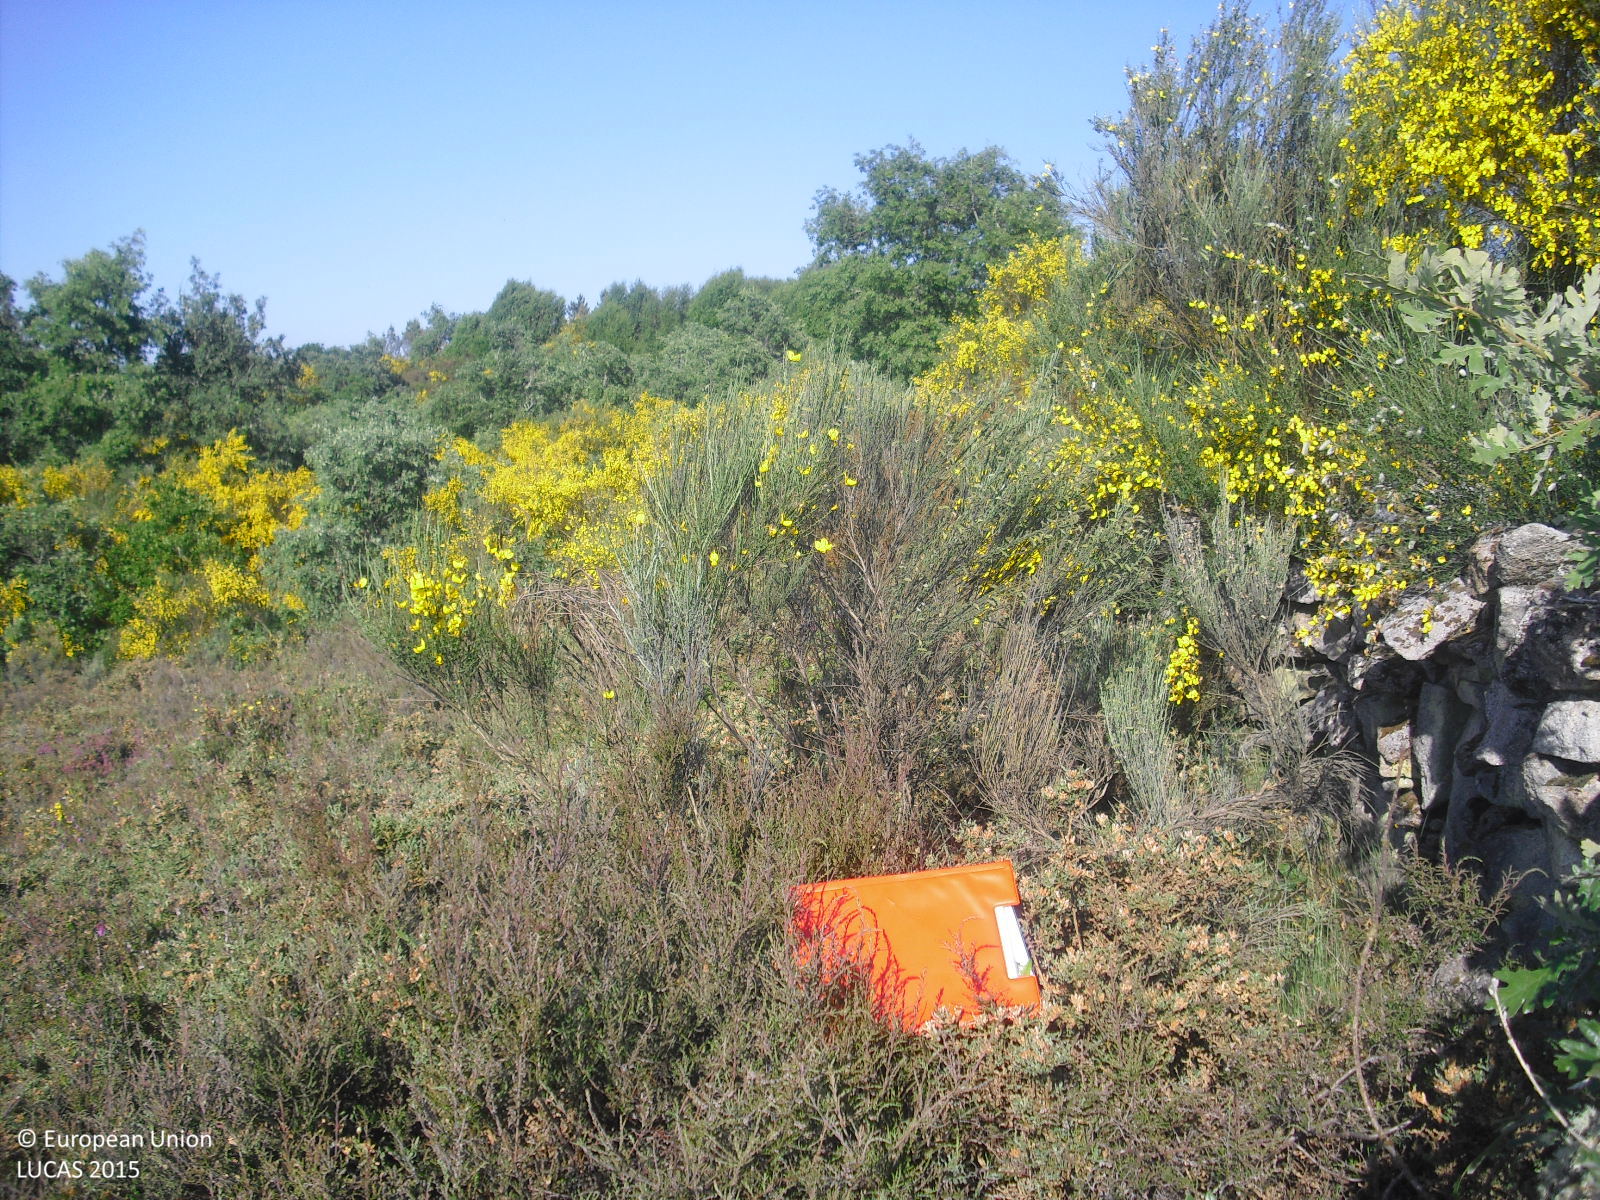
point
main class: Shrubland
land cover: Shrubland without tree cover
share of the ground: > 75 %
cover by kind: shrubs 100 %
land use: Semi-natural and natural areas not in use
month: May
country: ES
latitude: 42.2242
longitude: -7.6988
